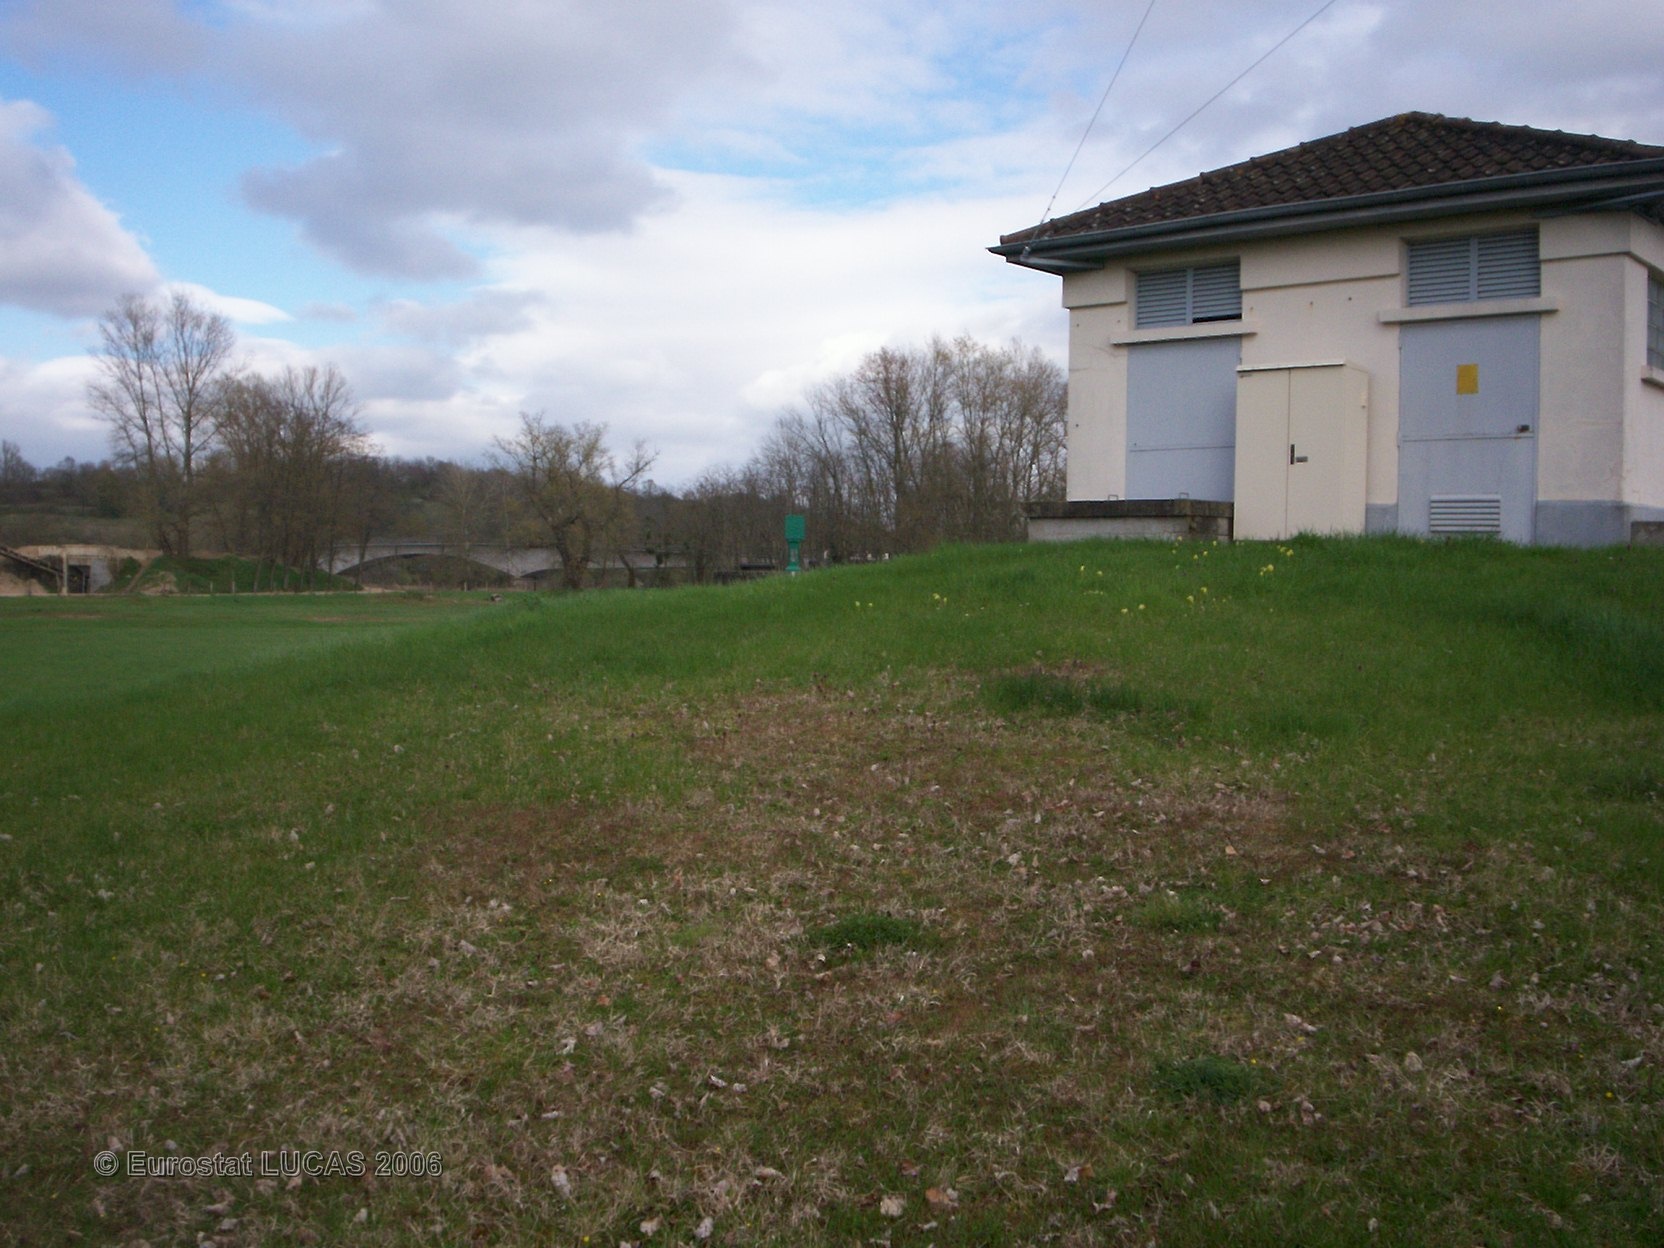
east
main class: Grassland
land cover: Grassland without tree/shrub cover
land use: Community services
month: April
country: FR
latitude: 46.7573
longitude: 3.0447
